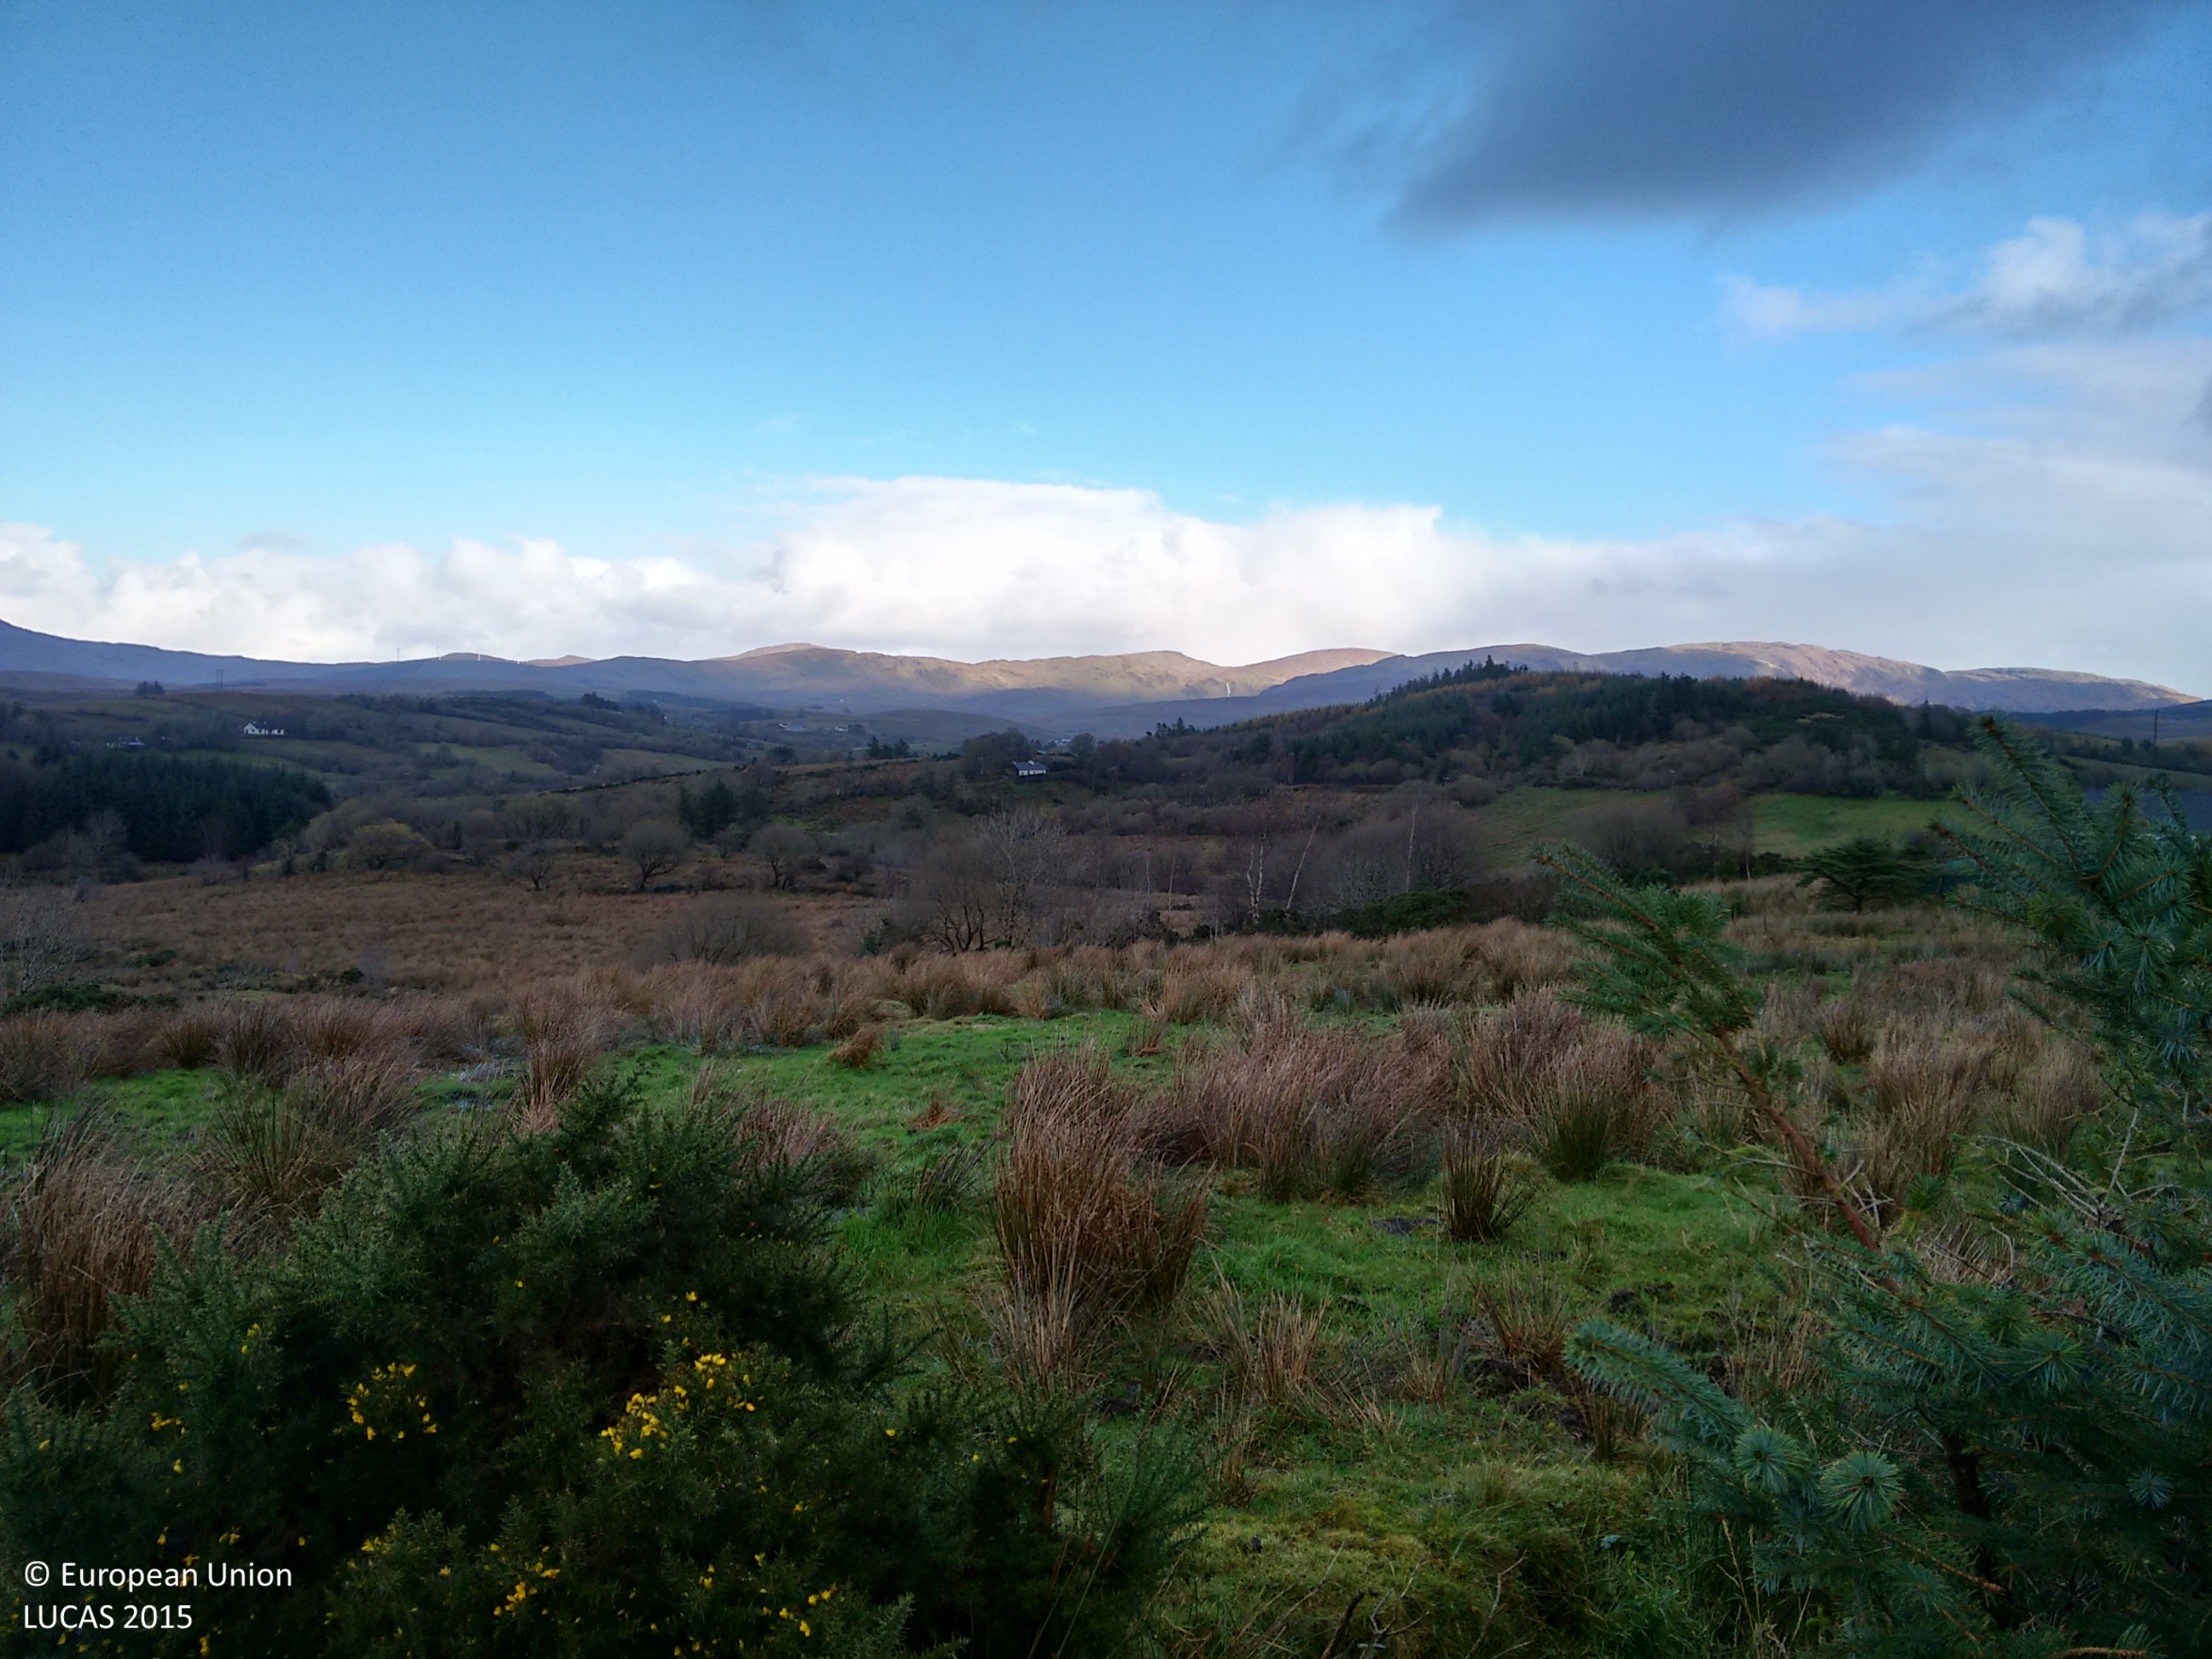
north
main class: Grassland
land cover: Grassland without tree/shrub cover
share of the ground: > 75 %
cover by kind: herbaceous plants 100 %
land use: Agriculture (excluding fallow land and kitchen gardens)
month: November
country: IE
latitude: 54.6899
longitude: -8.1581
